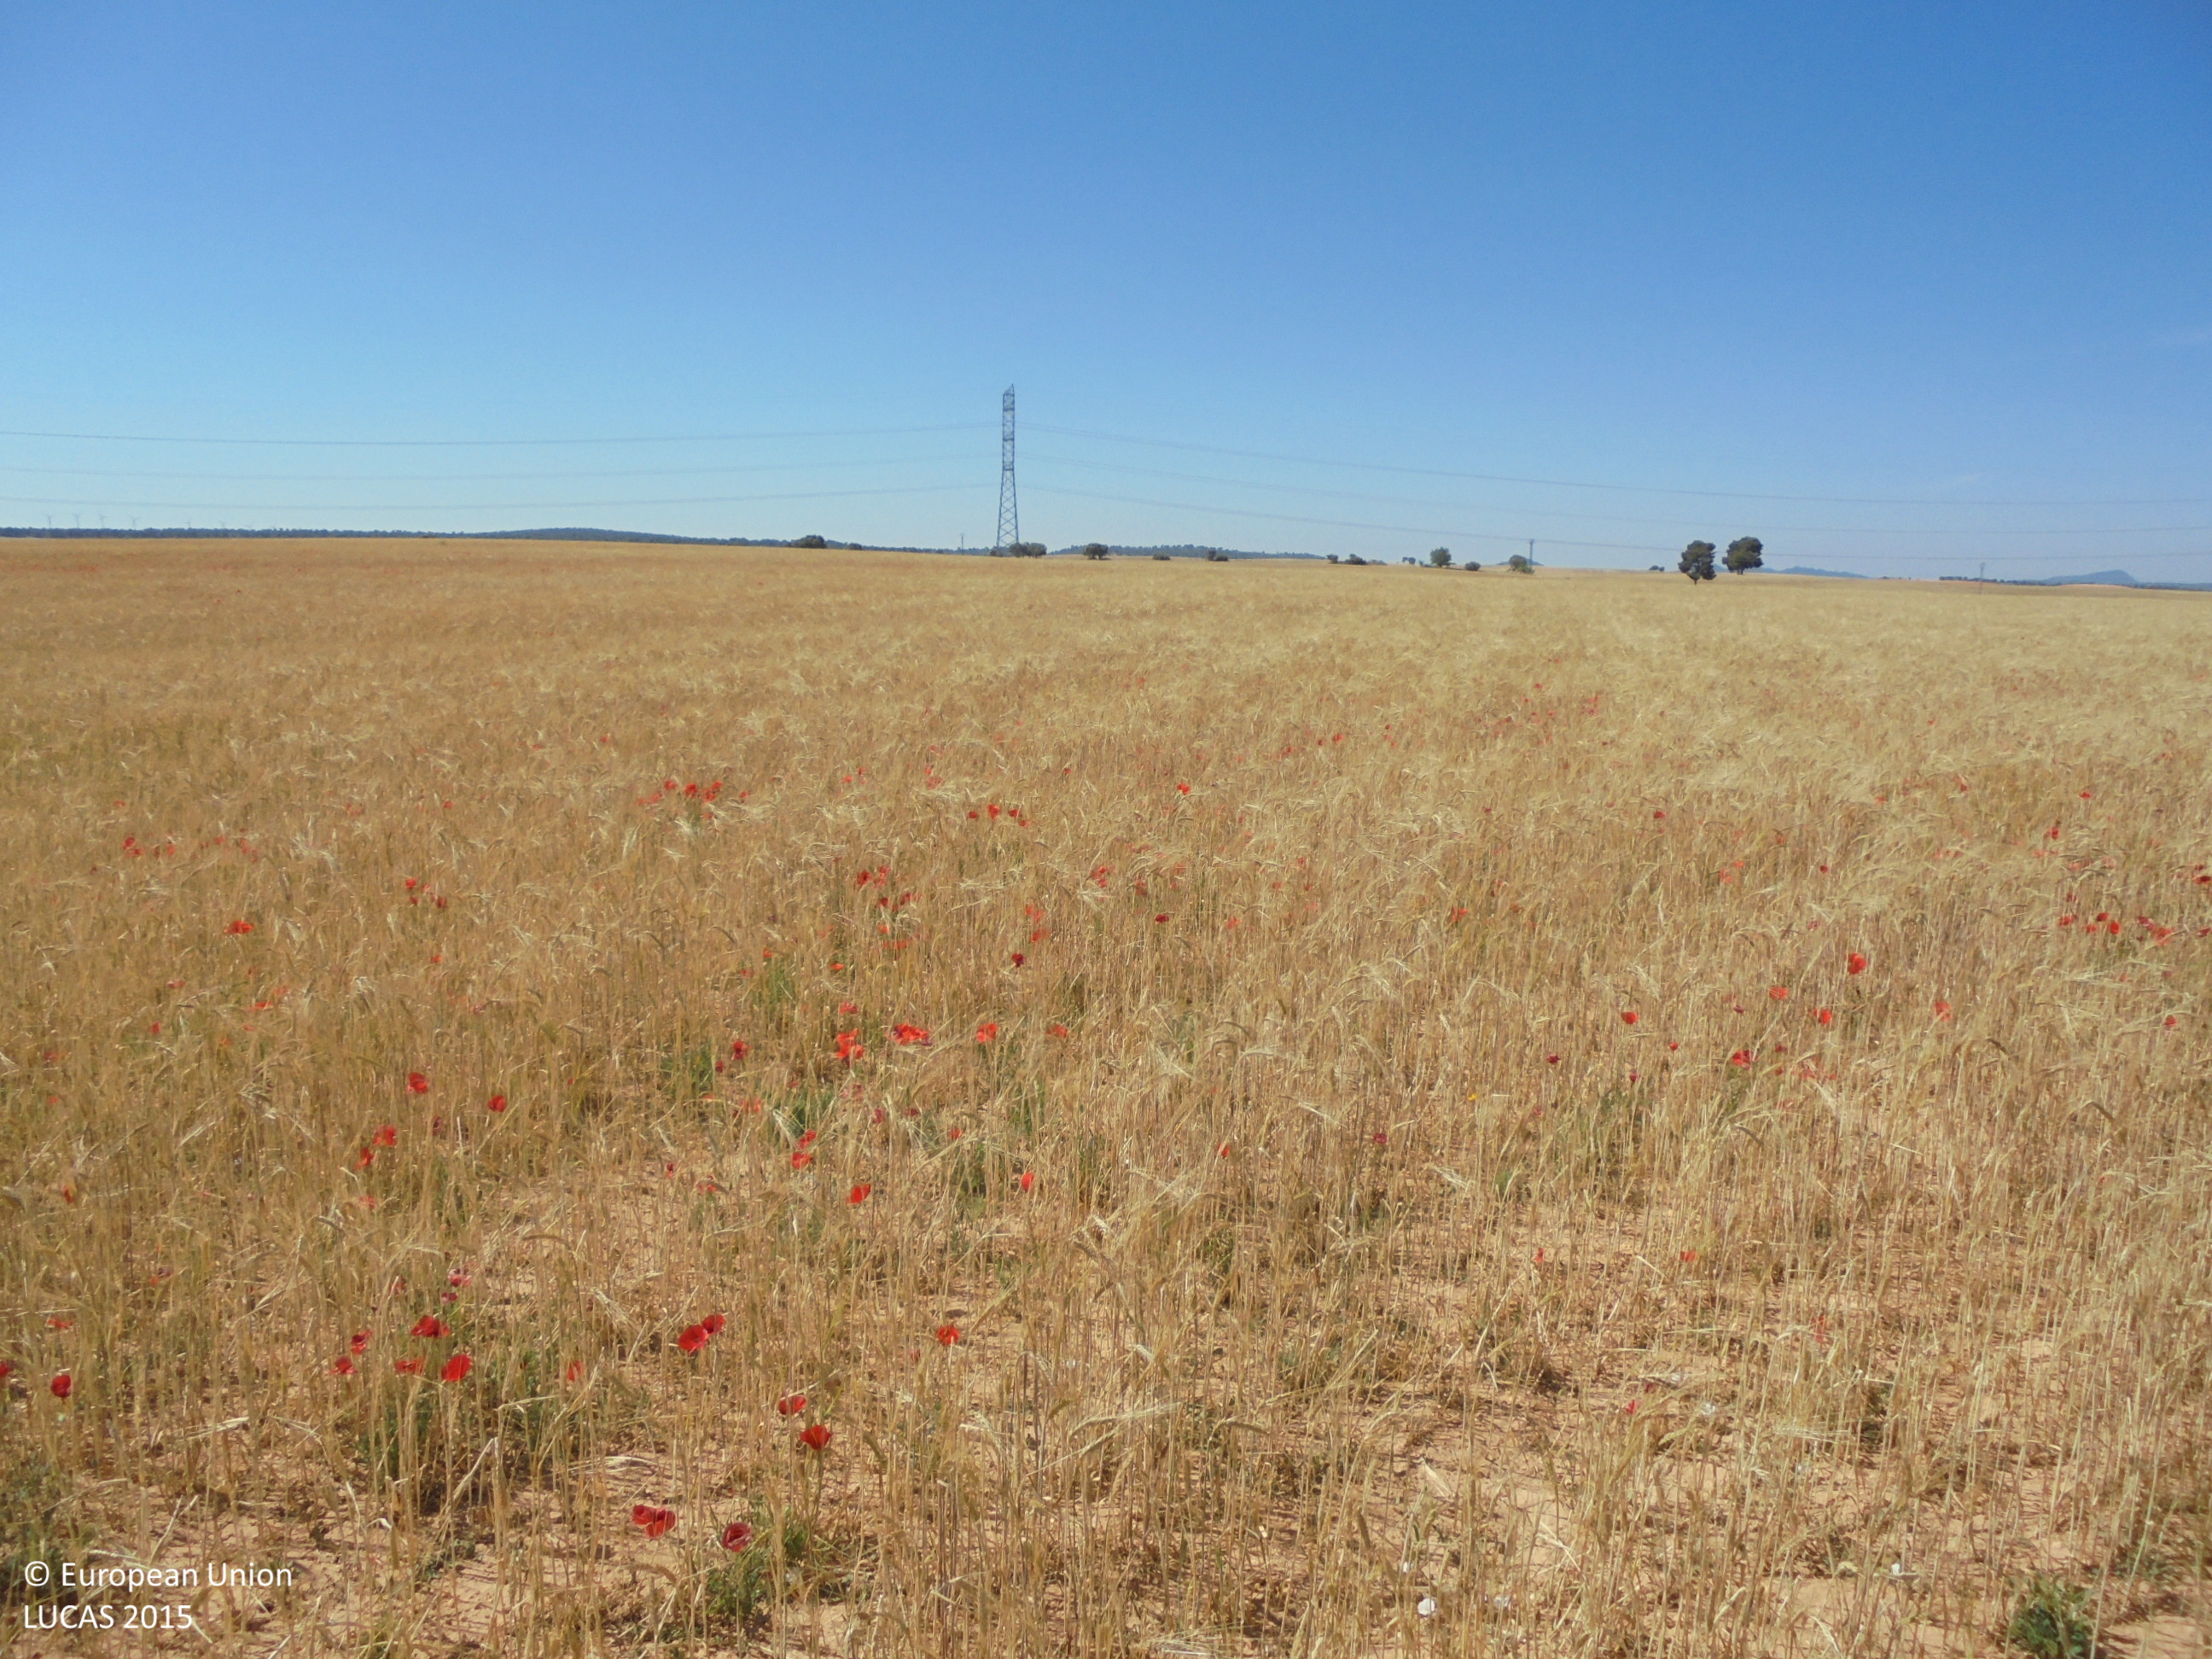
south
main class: Cropland
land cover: Barley
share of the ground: 25 - 50 %
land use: Agriculture (excluding fallow land and kitchen gardens)
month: June
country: ES
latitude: 38.7690
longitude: -1.6321
